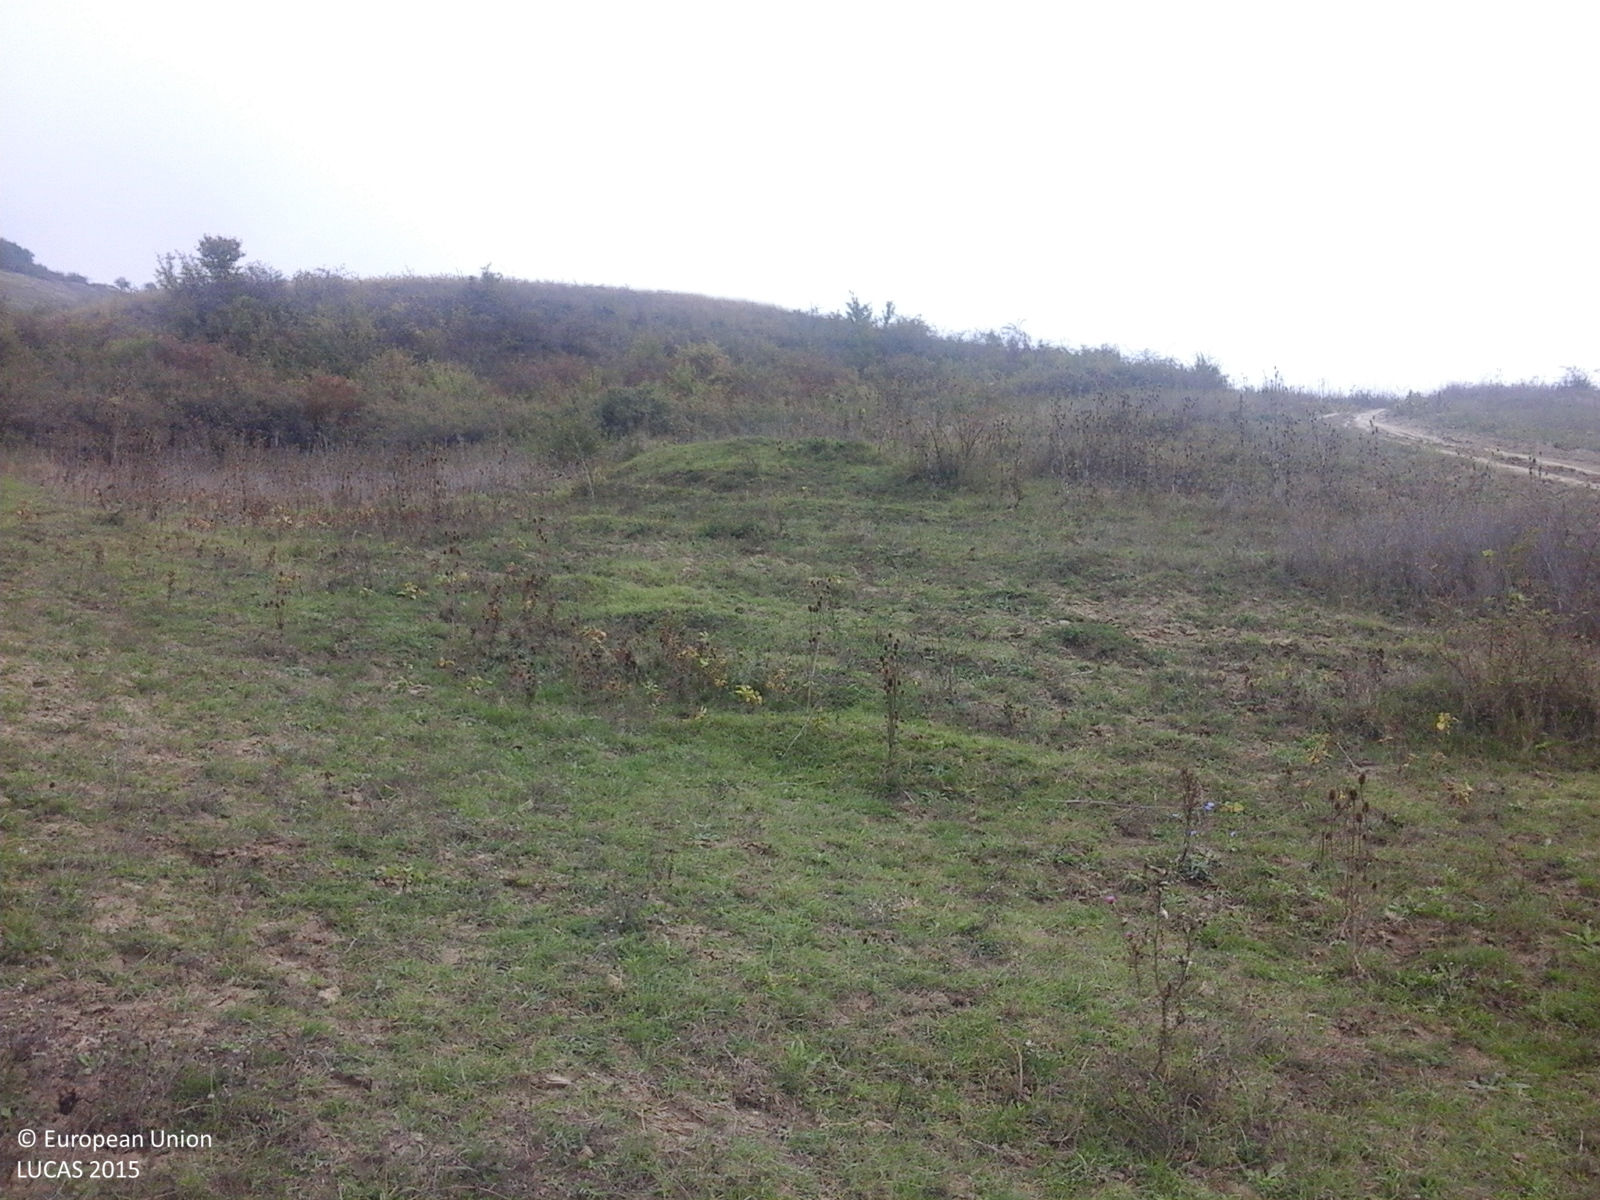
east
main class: Grassland
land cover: Grassland without tree/shrub cover
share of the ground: > 75 %
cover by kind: herbaceous plants 100 %
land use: Agriculture (excluding fallow land and kitchen gardens)
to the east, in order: Grassland without tree/shrub cover; Shrubland with sparse tree cover; Grassland with sparse tree/shrub cover; Grassland without tree/shrub cover
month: October
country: RO
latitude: 46.0329
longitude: 23.9621
